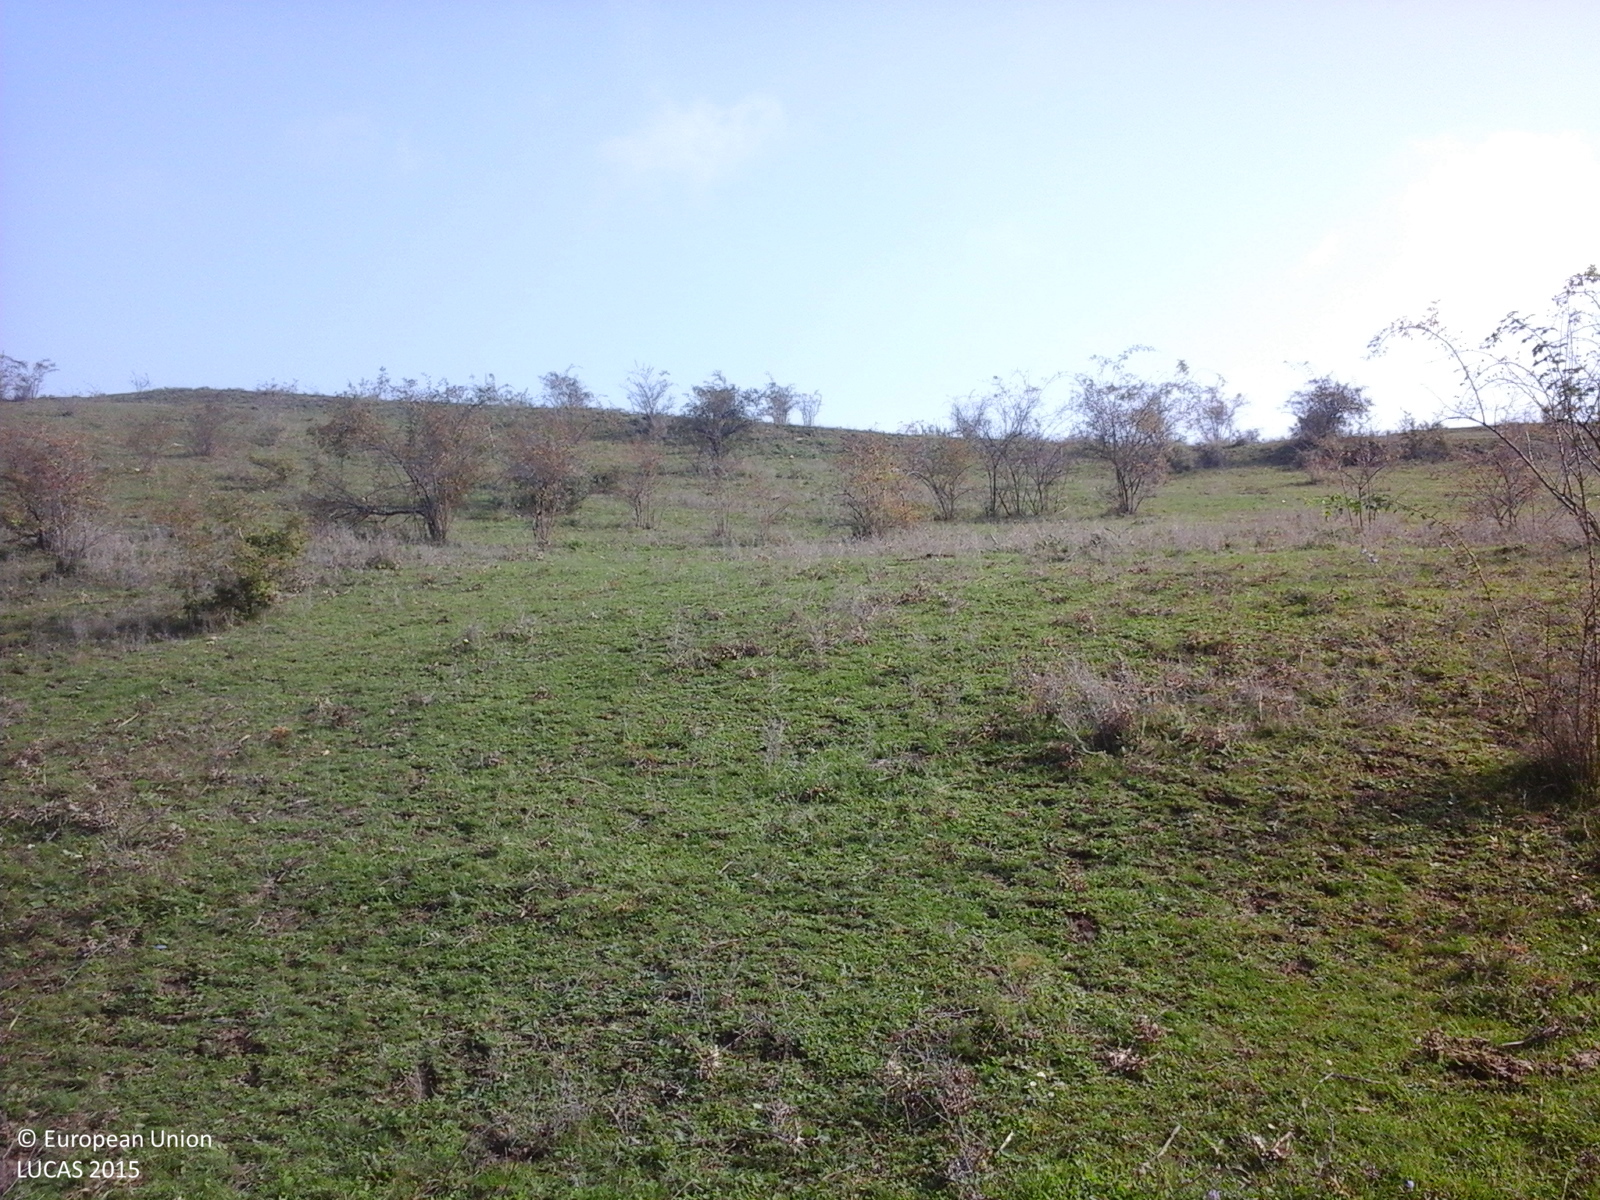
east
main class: Grassland
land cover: Grassland with sparse tree/shrub cover
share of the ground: > 75 %
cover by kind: herbaceous plants 85 %, shrubs 10 %, broadleaved forest trees 5 %
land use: Agriculture (excluding fallow land and kitchen gardens)
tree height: > 5 m
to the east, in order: Grassland with sparse tree/shrub cover
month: October
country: RO
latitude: 46.1423
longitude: 23.5426
